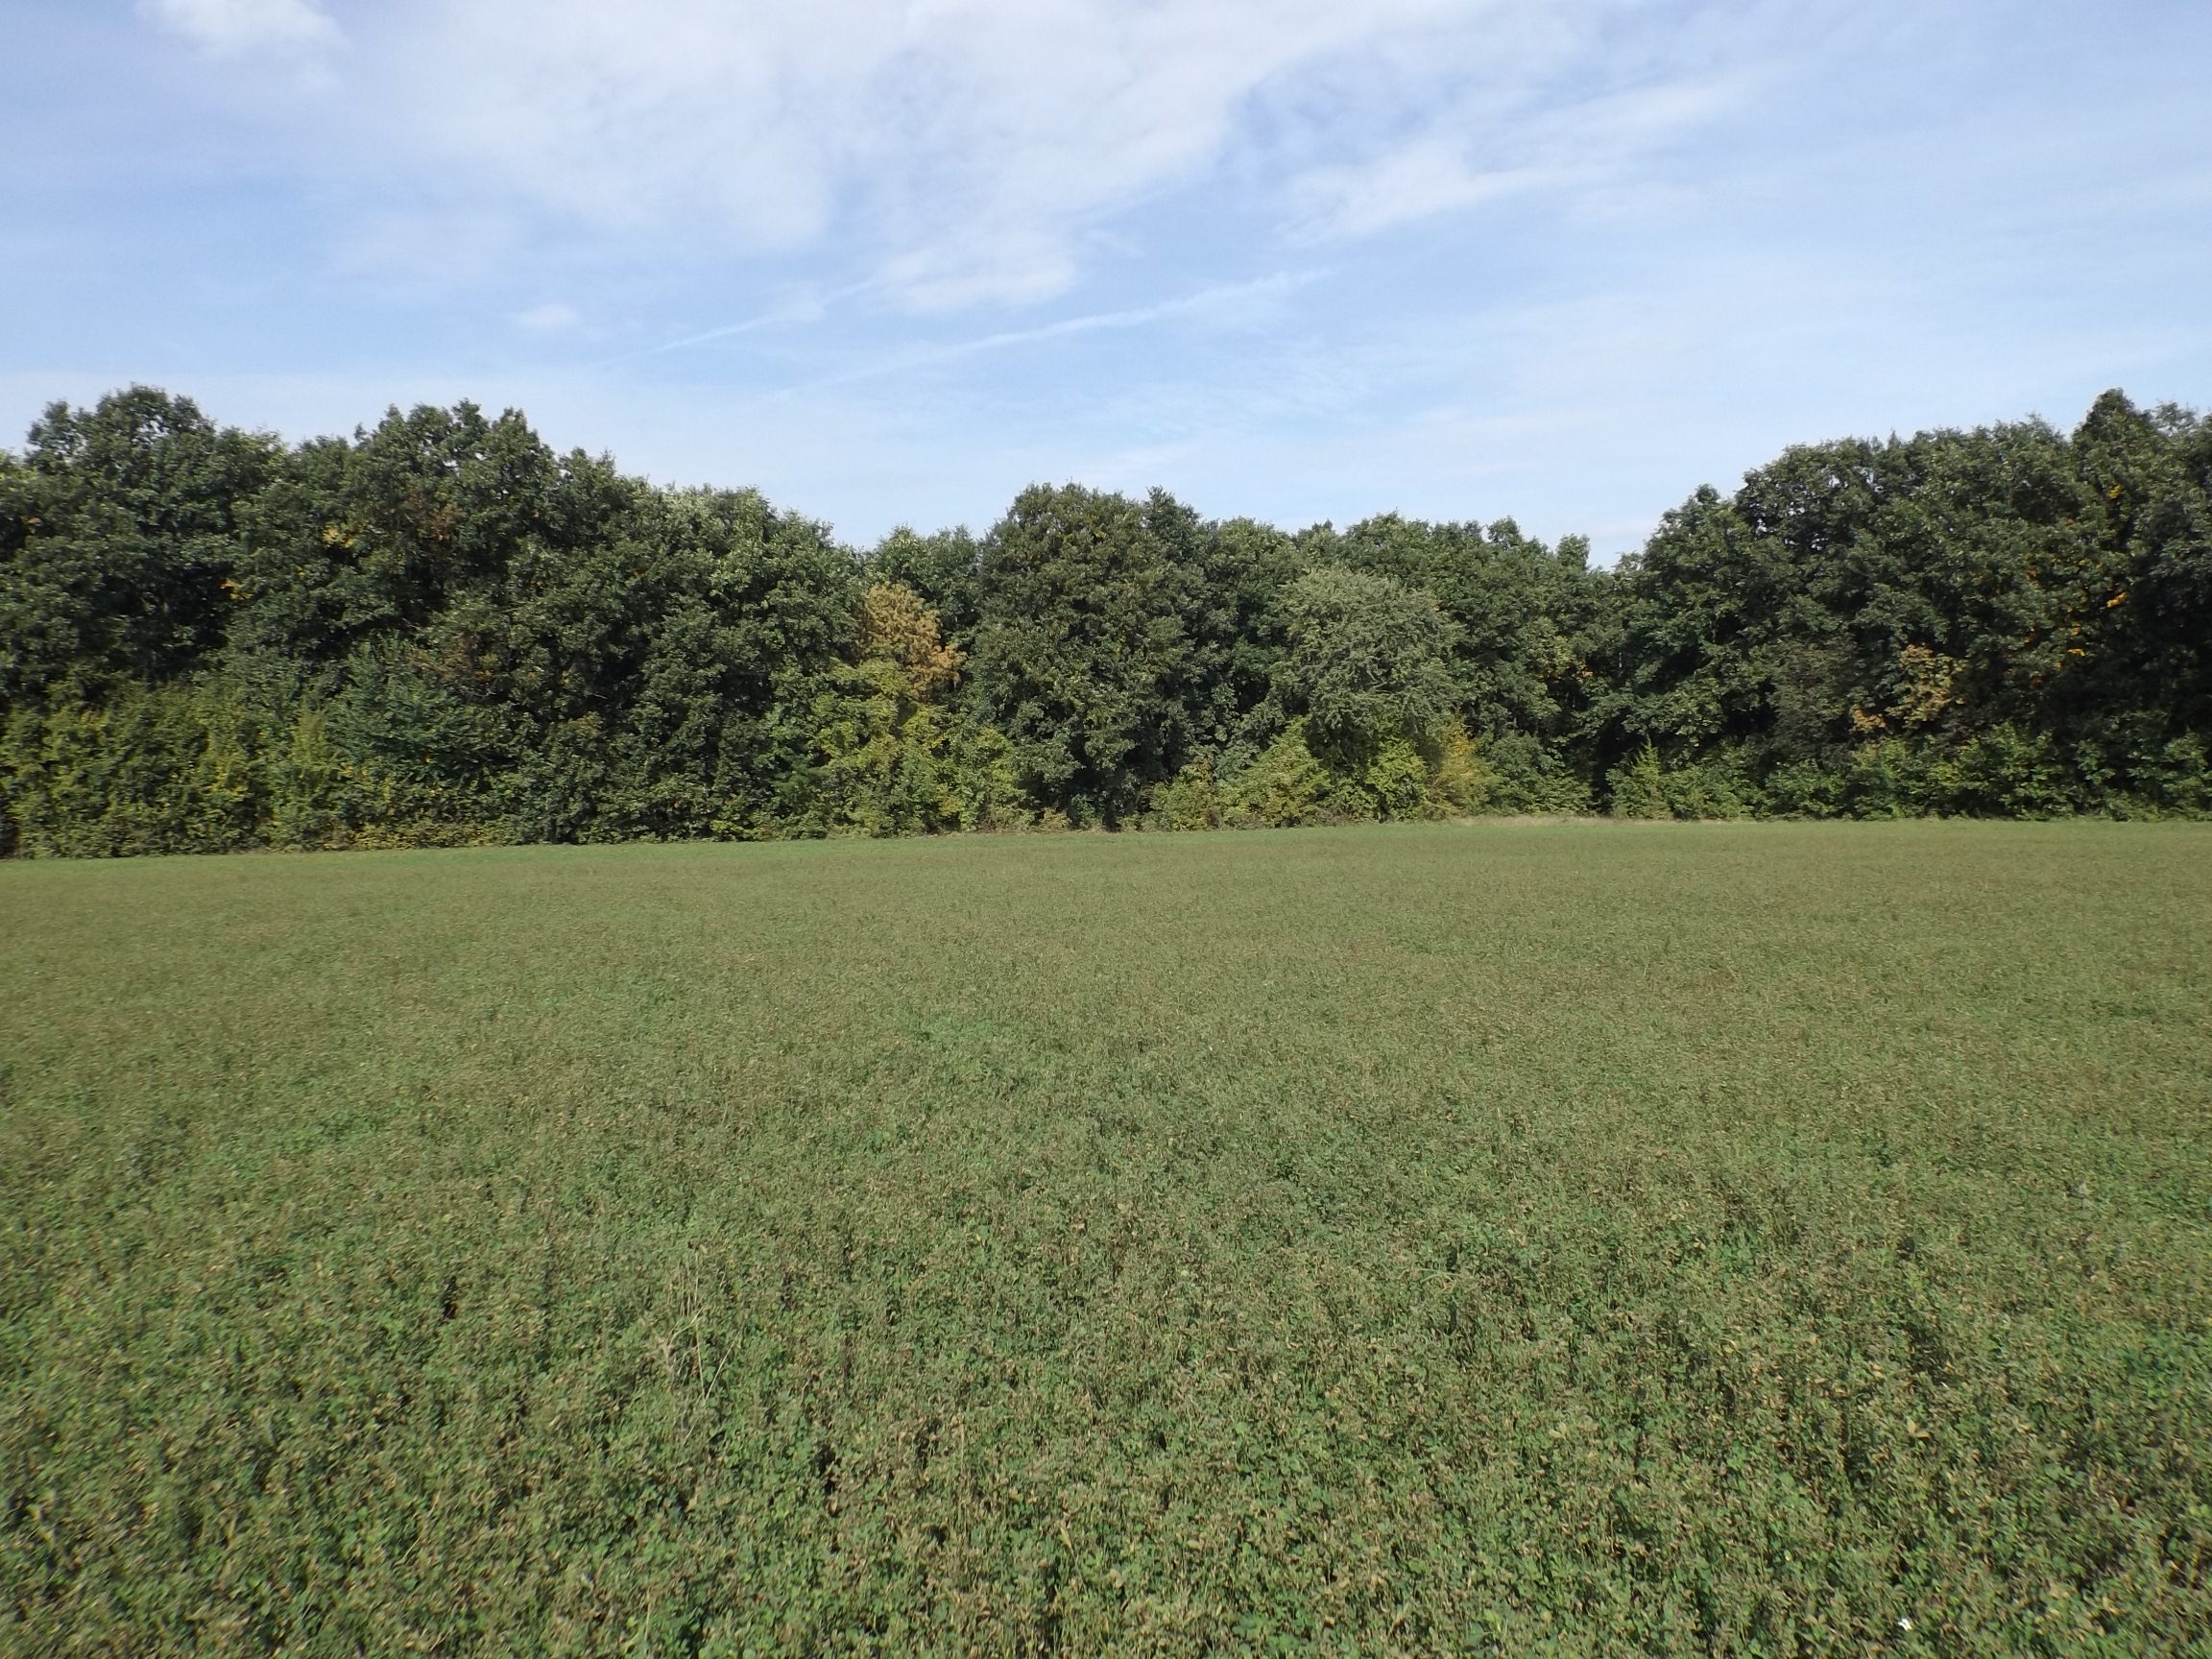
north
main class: Cropland
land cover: Lucerne
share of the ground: > 75 %
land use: Agriculture (excluding fallow land and kitchen gardens)
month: October
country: BG
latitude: 43.8736
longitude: 26.7792
